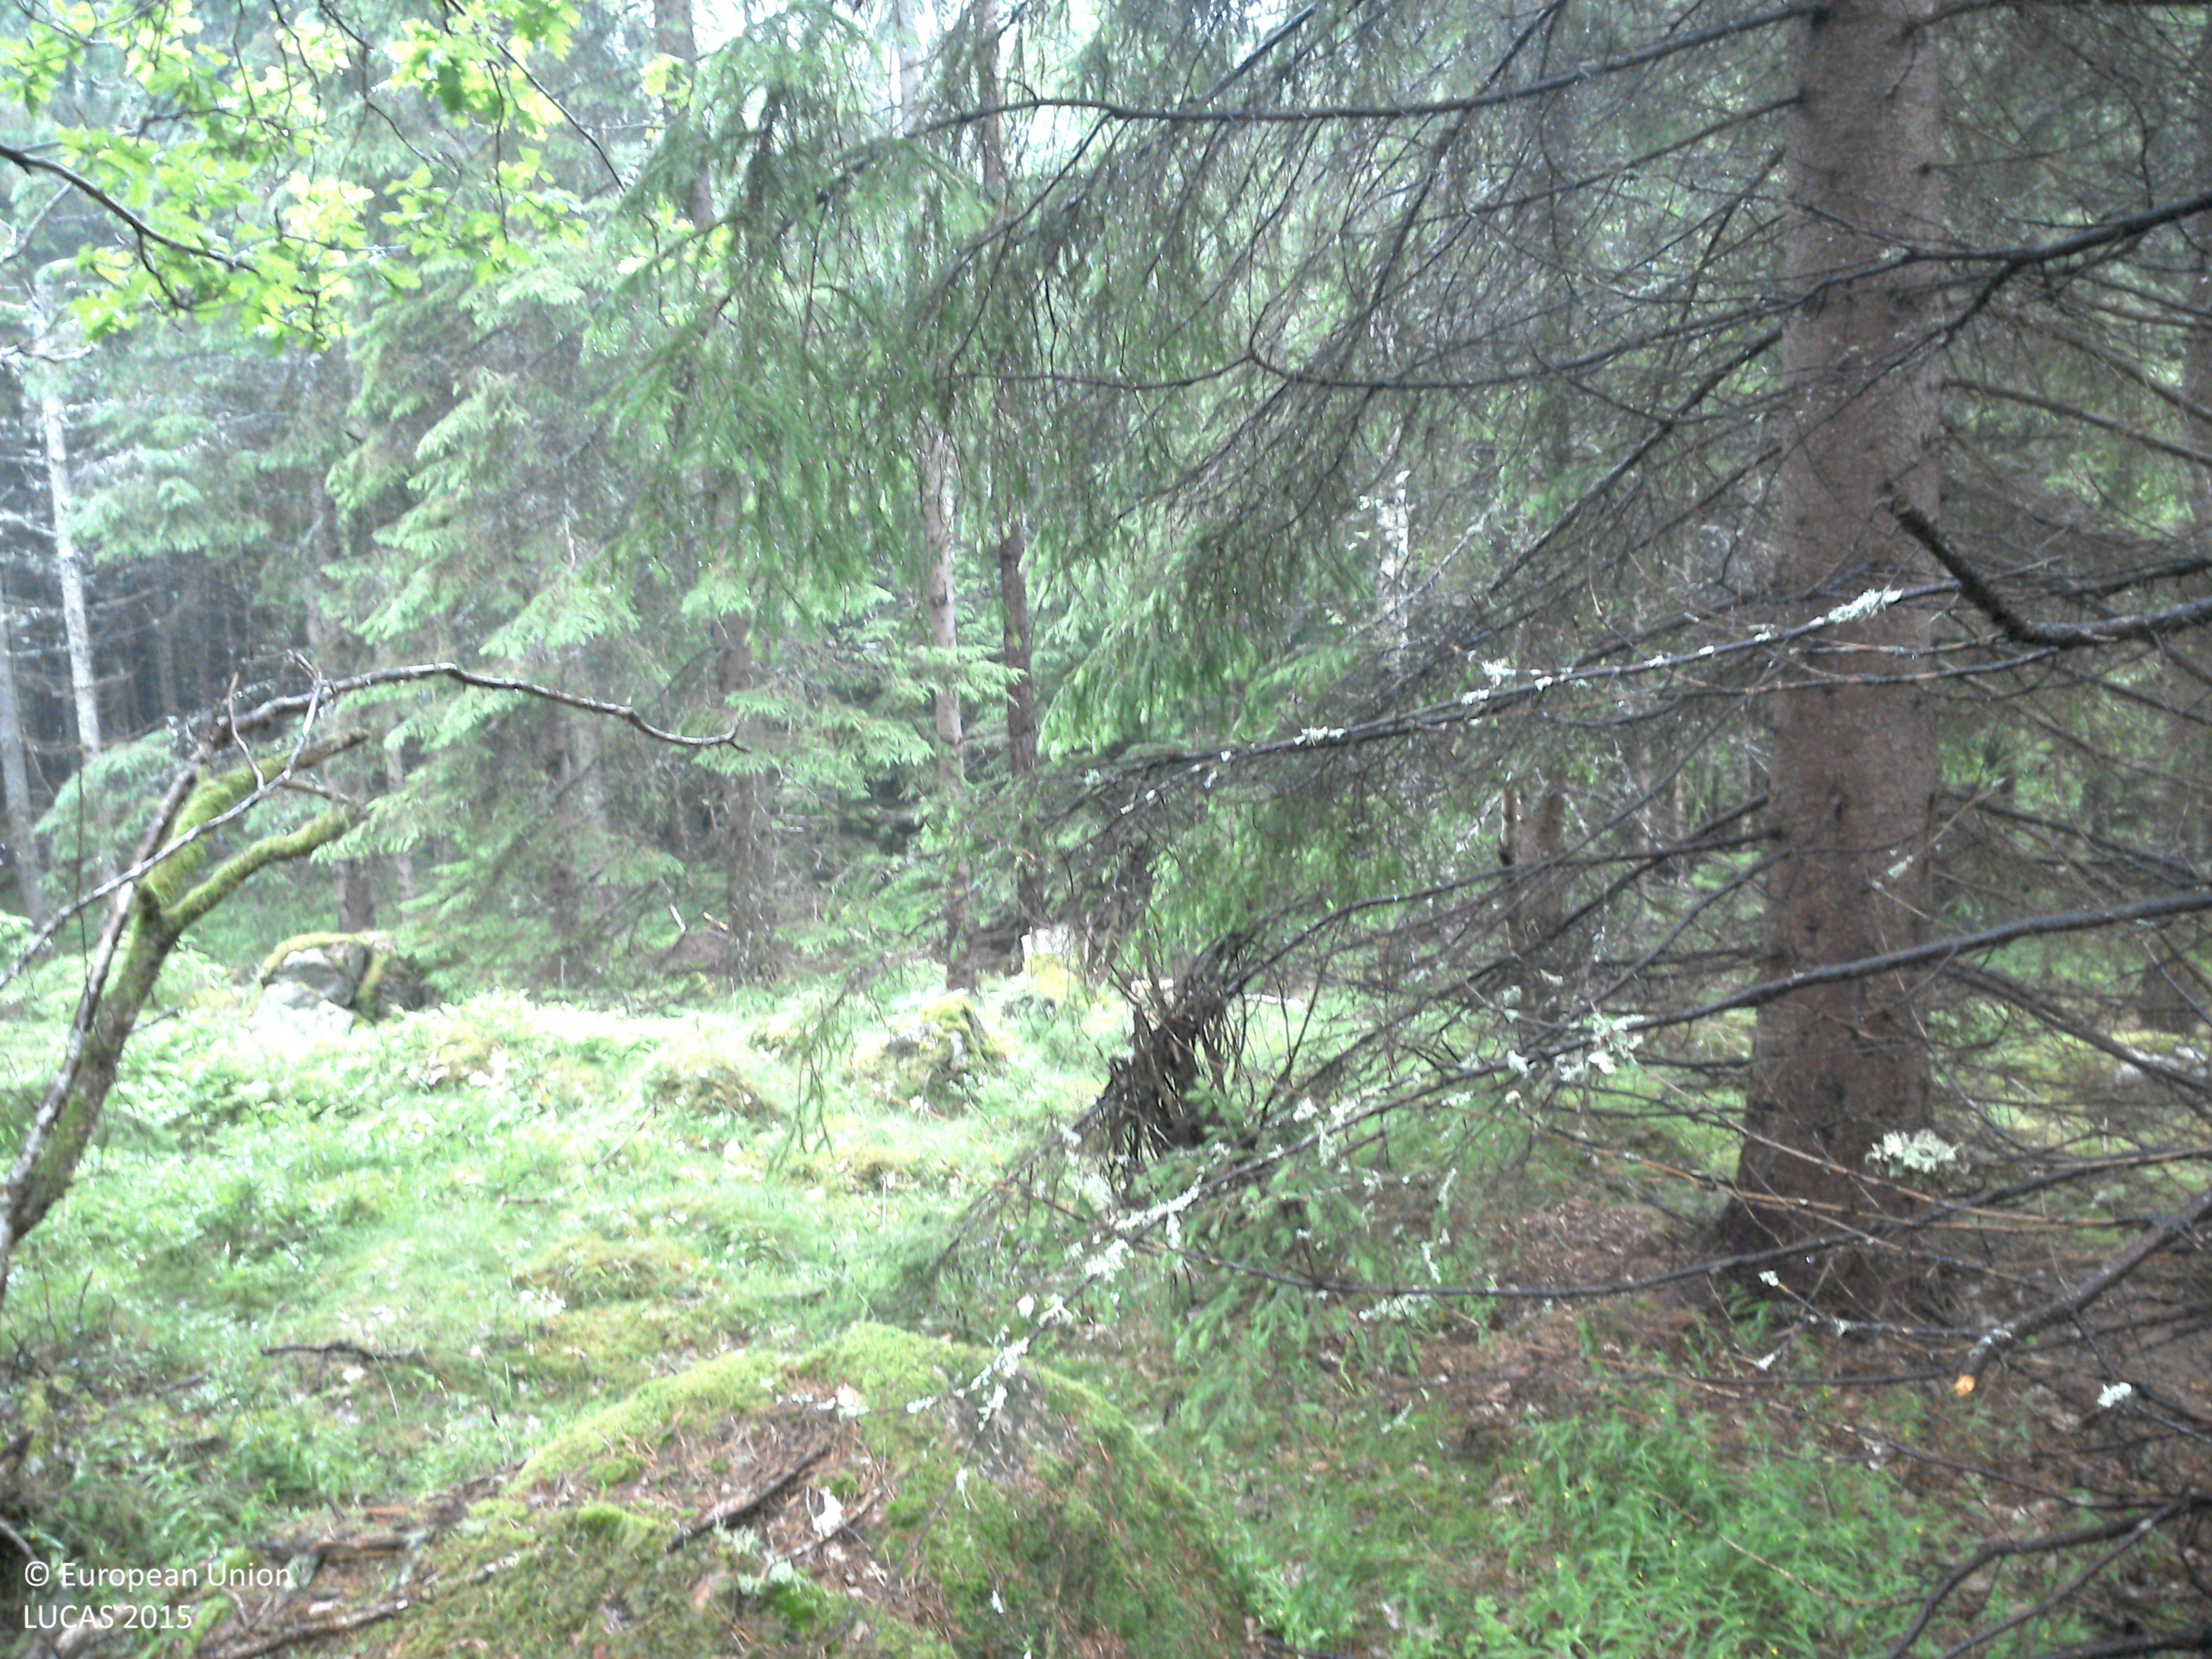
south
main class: Woodland
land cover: Pine dominated coniferous woodland
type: boreal forest
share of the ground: > 75 %
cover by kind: coniferous forest trees 75 %, herbaceous plants 20 %, lichens and mosses 5 %
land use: Forestry
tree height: > 5 m
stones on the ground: < 10 %
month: July
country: SE
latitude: 58.5940
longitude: 15.0346
